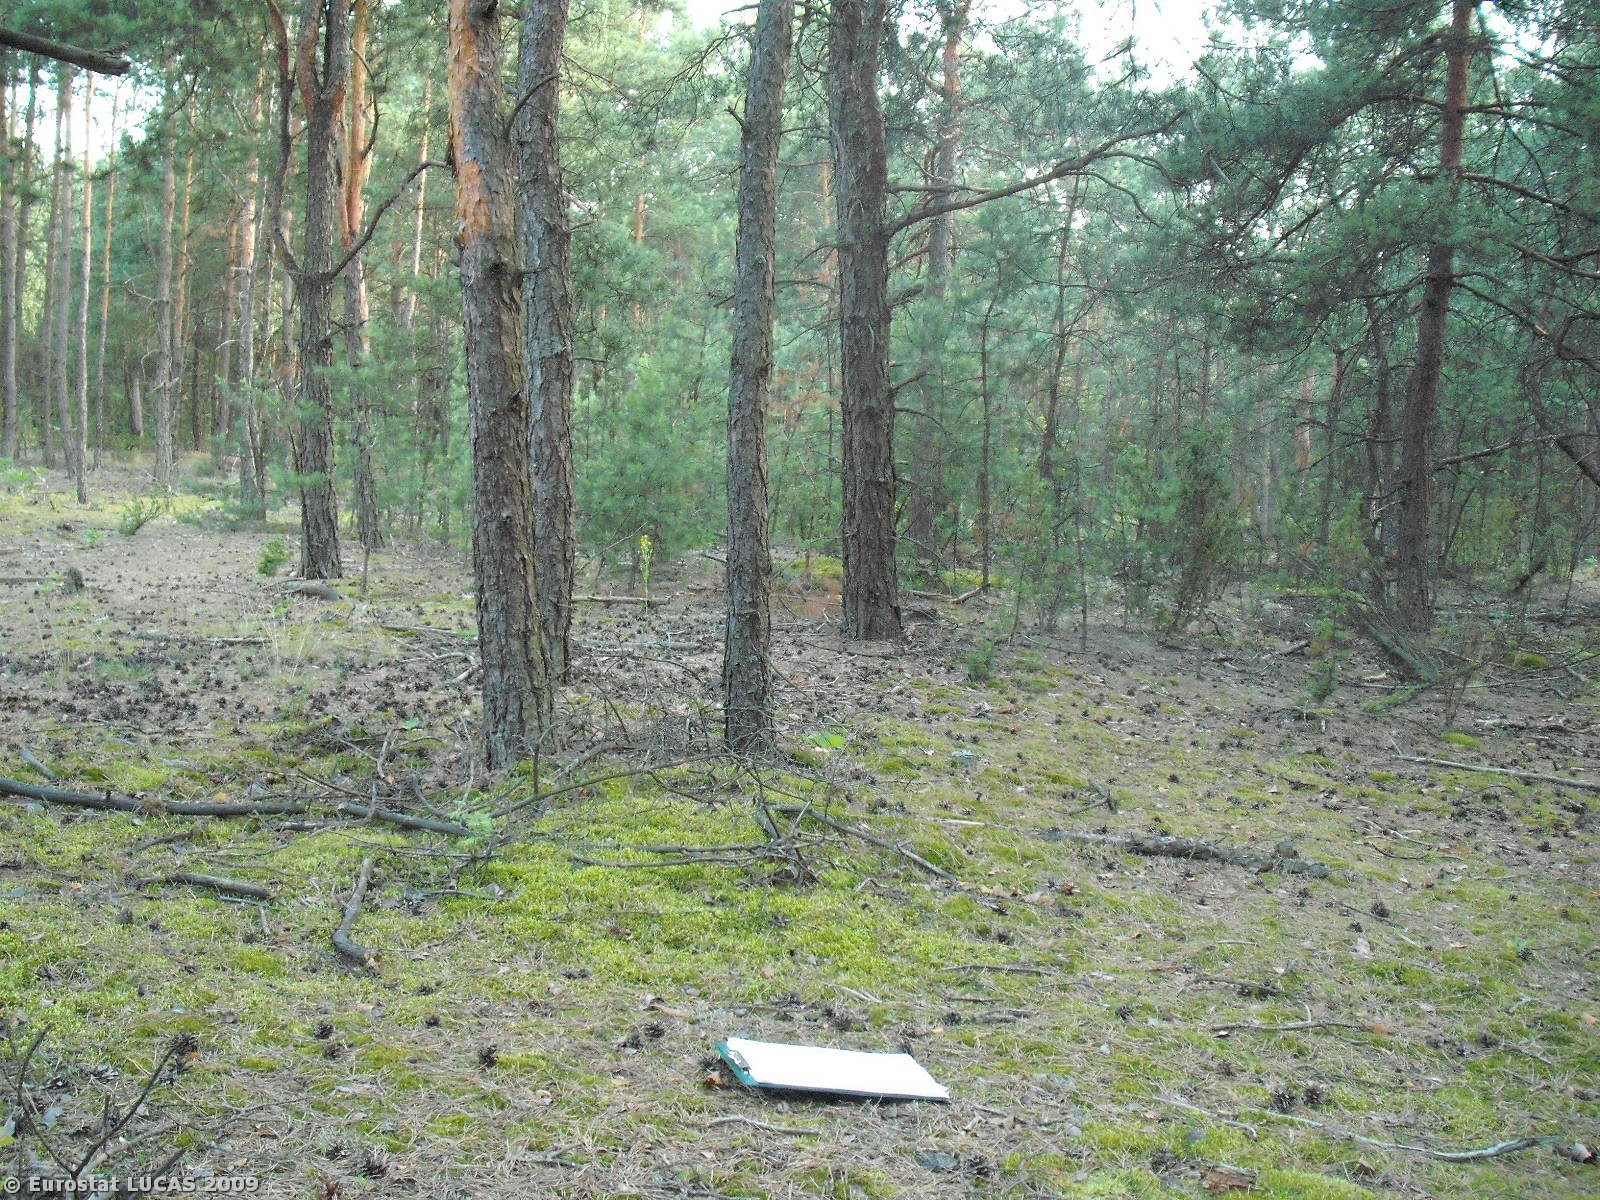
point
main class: Woodland
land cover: Coniferous woodland
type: hemiboreal forest and nemoral coniferous forest and mixed broadleaved-coniferous forest
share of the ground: > 75 %
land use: Forestry
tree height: > 5 m
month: July
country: PL
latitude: 52.2836
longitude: 20.7865
